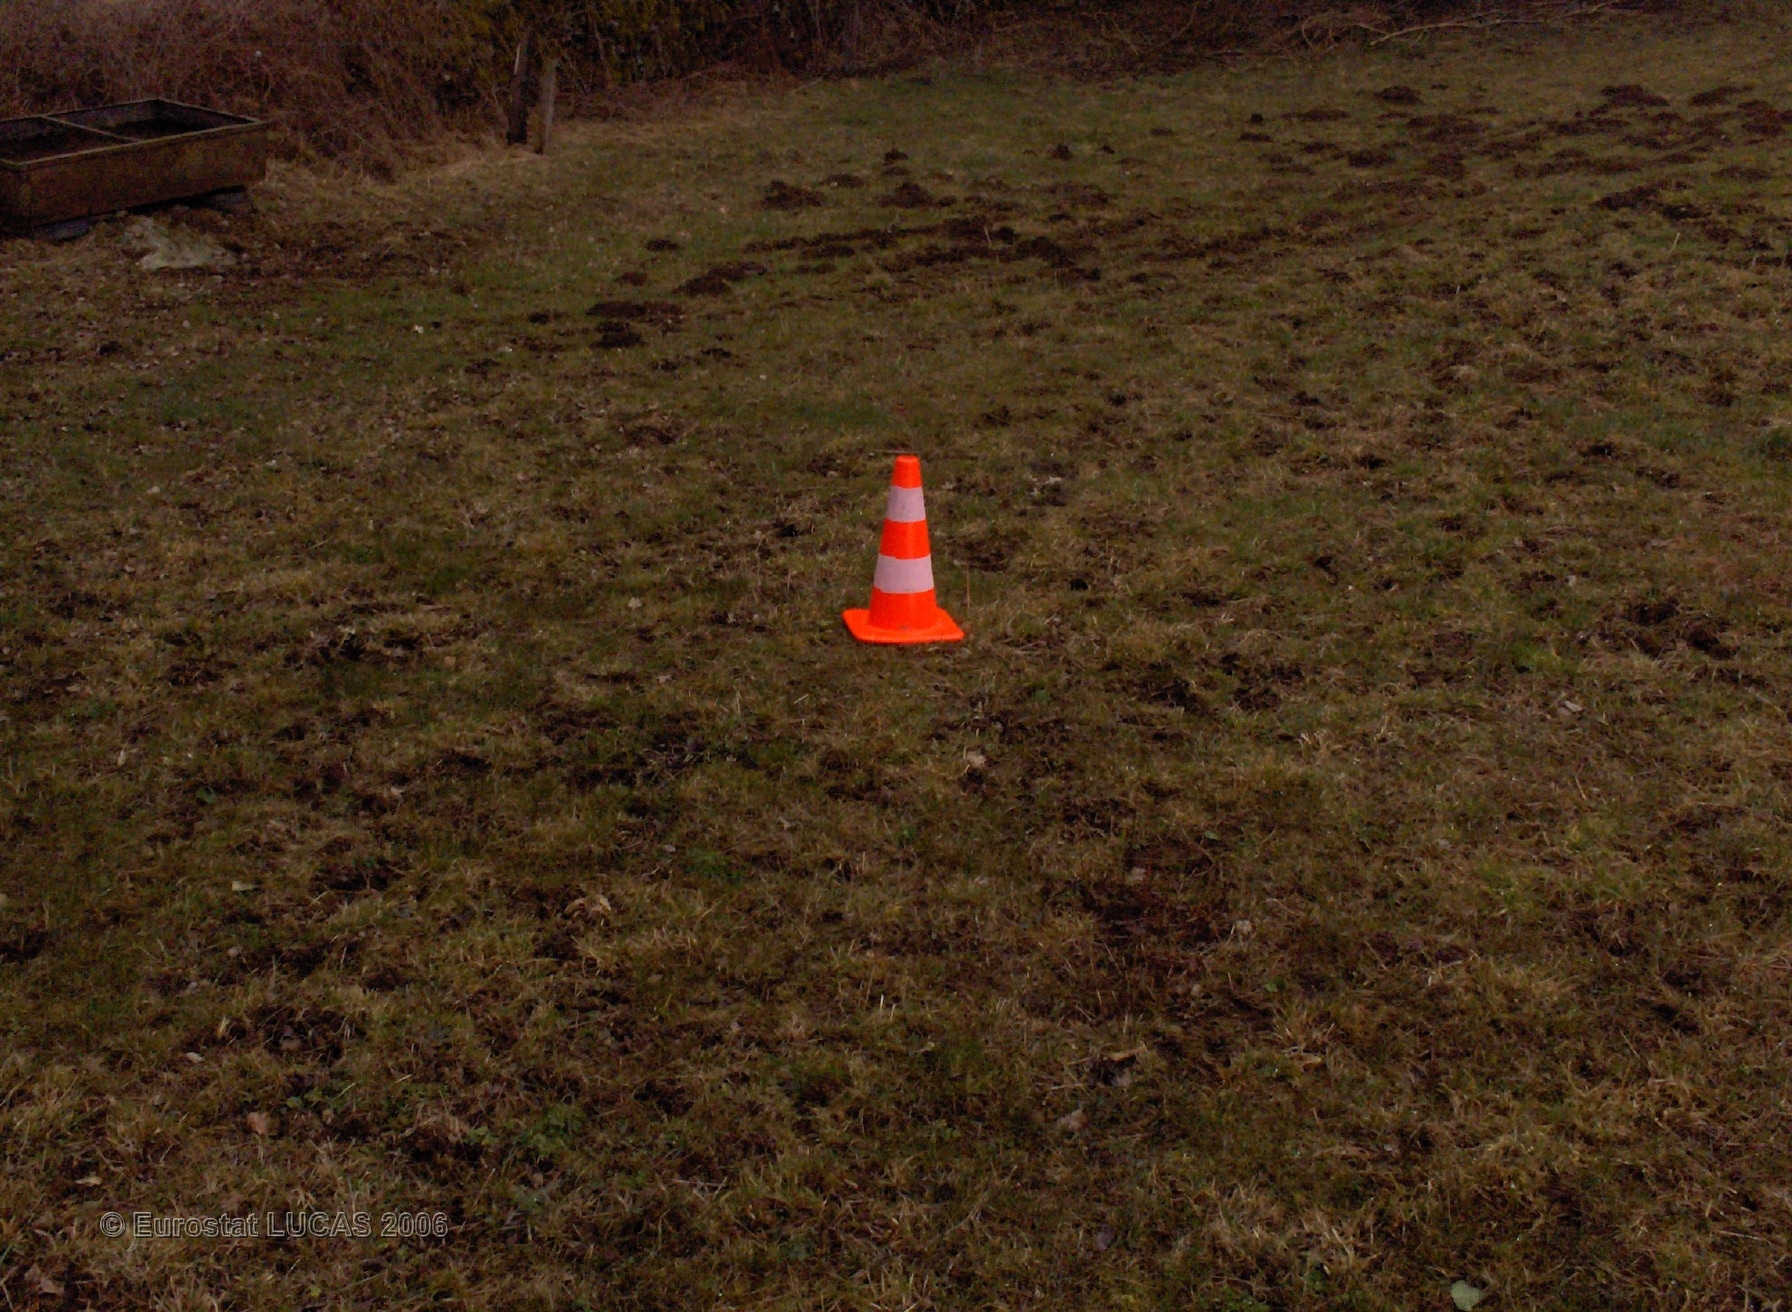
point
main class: Grassland
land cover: Grassland without tree/shrub cover
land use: Agriculture (excluding fallow land and kitchen gardens)
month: March
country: BE
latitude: 50.4636
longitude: 5.2502
